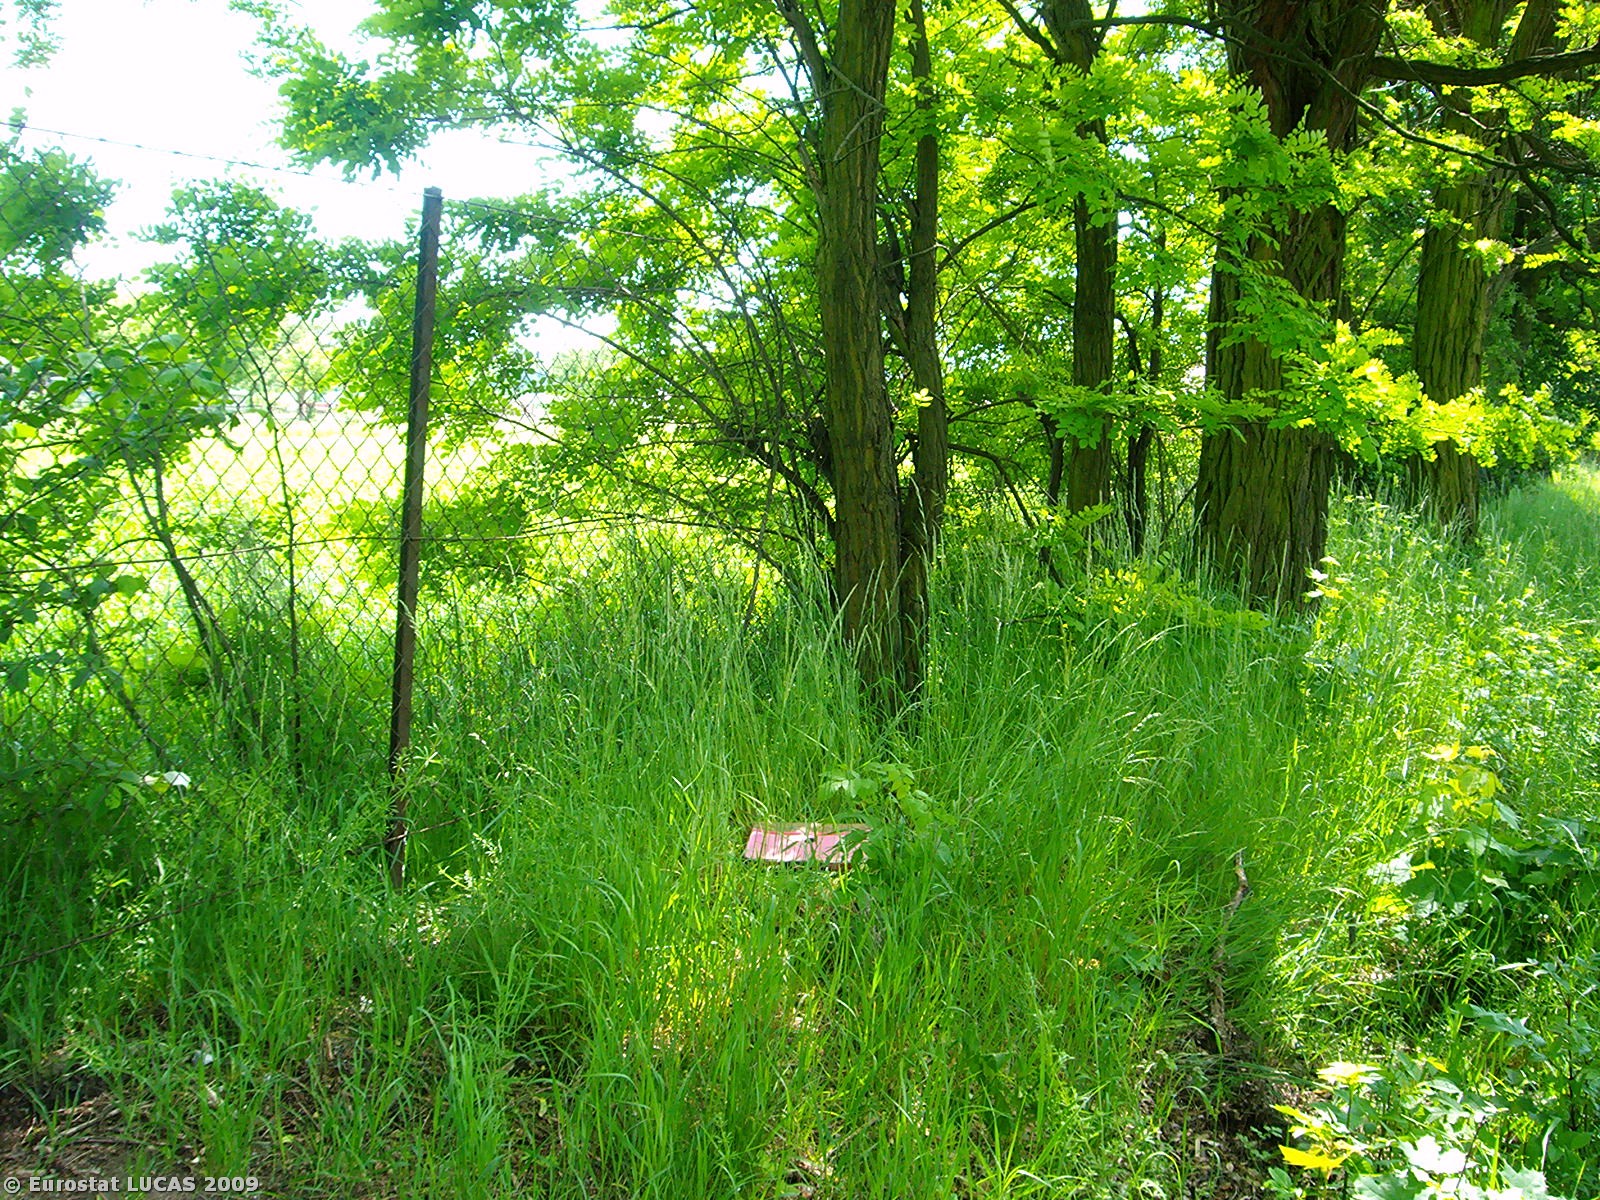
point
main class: Woodland
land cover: Broadleaved woodland
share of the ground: > 75 %
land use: Unused
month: May
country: PL
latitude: 52.4970
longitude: 16.9768
